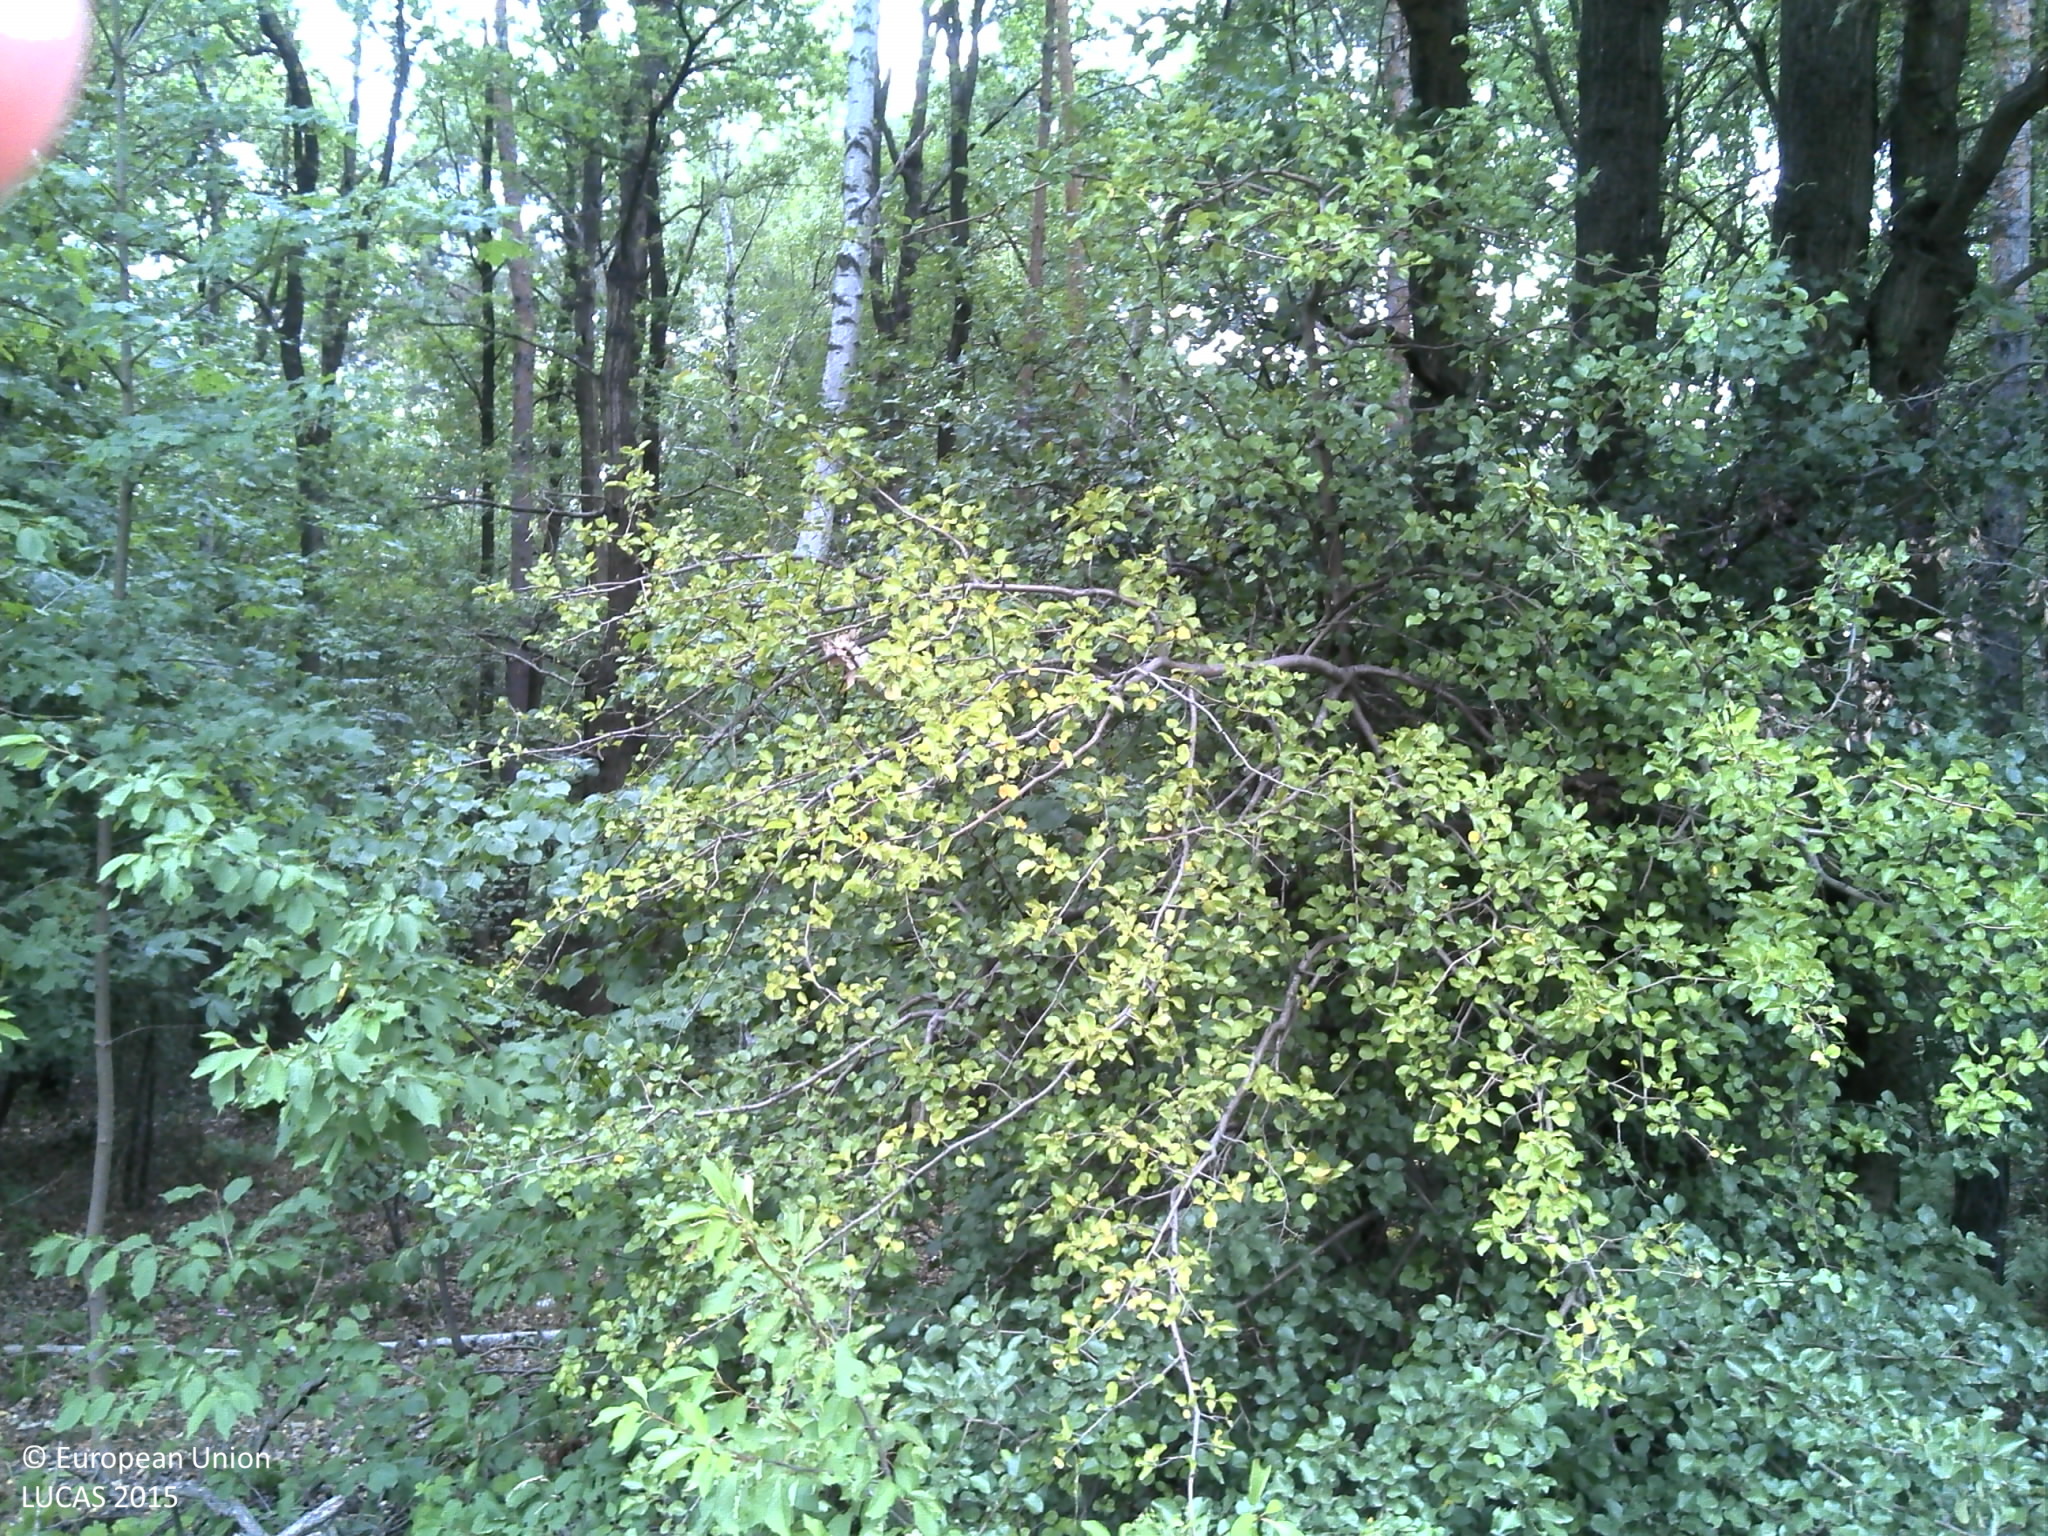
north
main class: Woodland
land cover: Pine dominated mixed woodland
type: hemiboreal forest and nemoral coniferous forest and mixed broadleaved-coniferous forest
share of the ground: > 75 %
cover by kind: broadleaved forest trees 55 %, coniferous forest trees 35 %, herbaceous plants 10 %
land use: Forestry
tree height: > 5 m
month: July
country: FR
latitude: 48.6891
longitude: 2.4768
